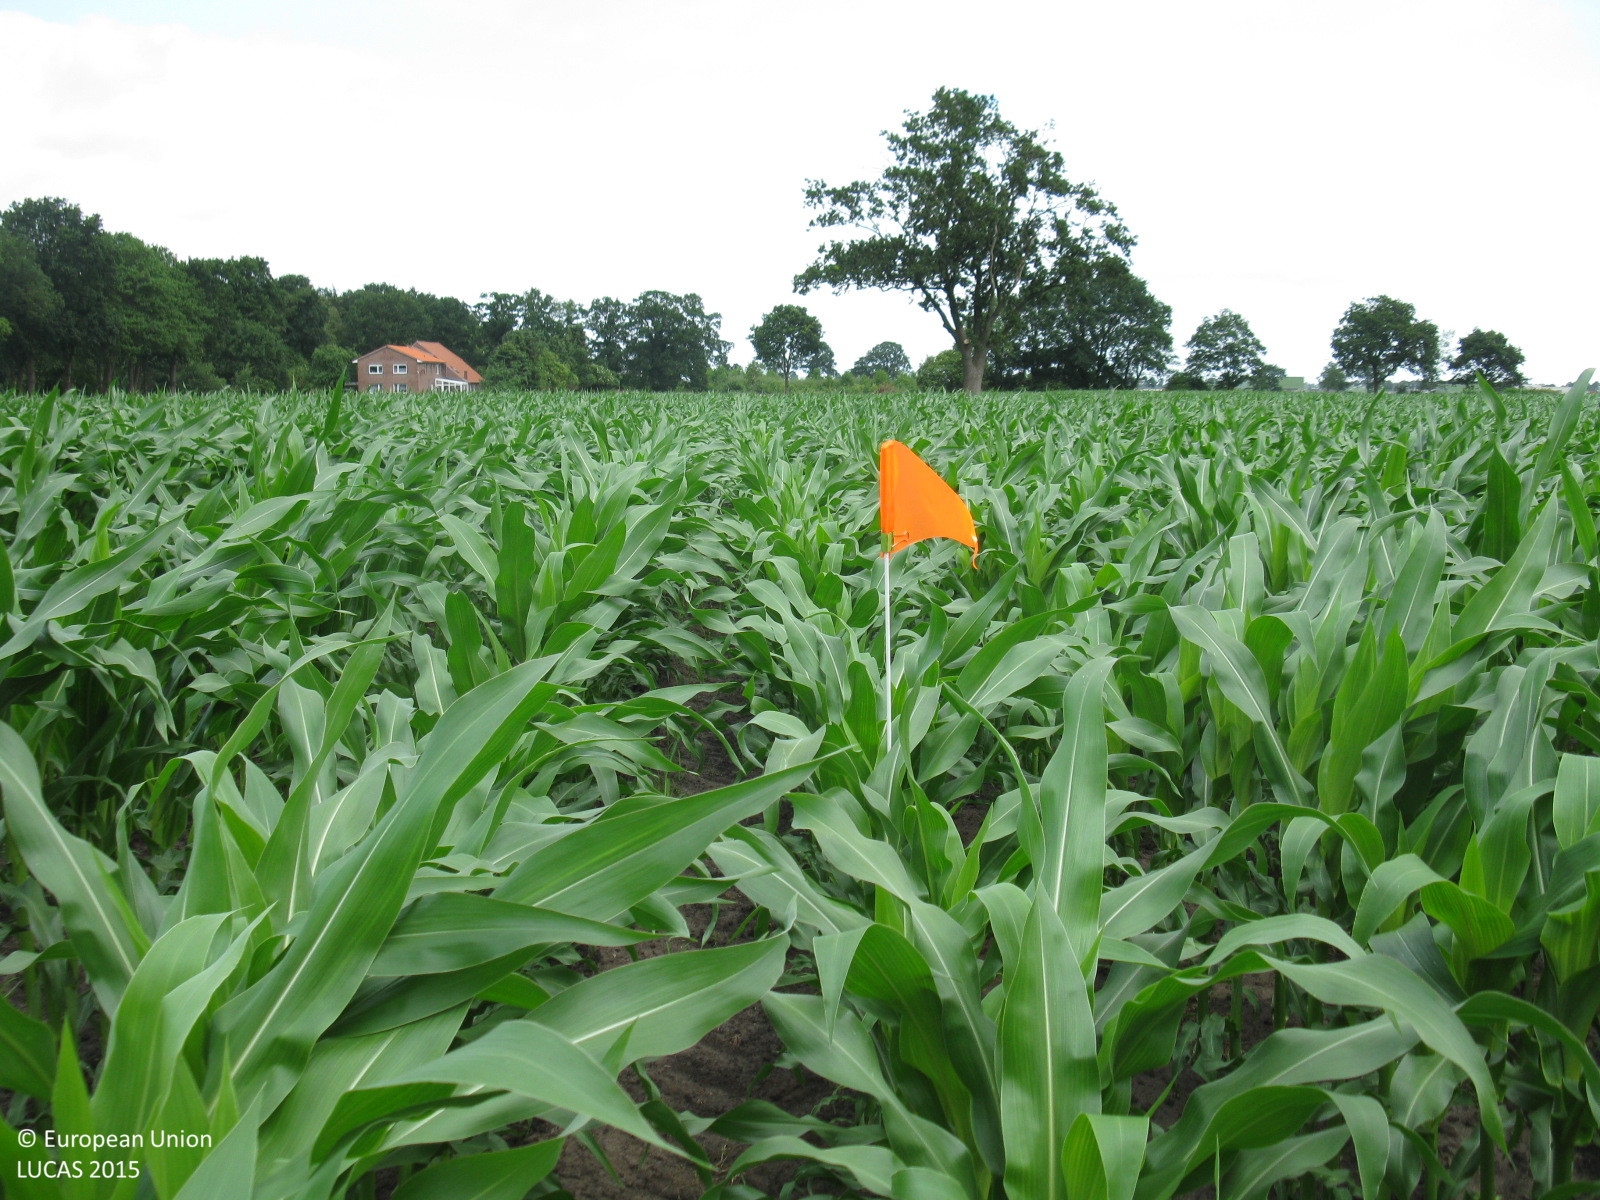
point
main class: Cropland
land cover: Maize
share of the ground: > 75 %
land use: Agriculture (excluding fallow land and kitchen gardens)
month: July
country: DE
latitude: 53.4558
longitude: 7.9074
